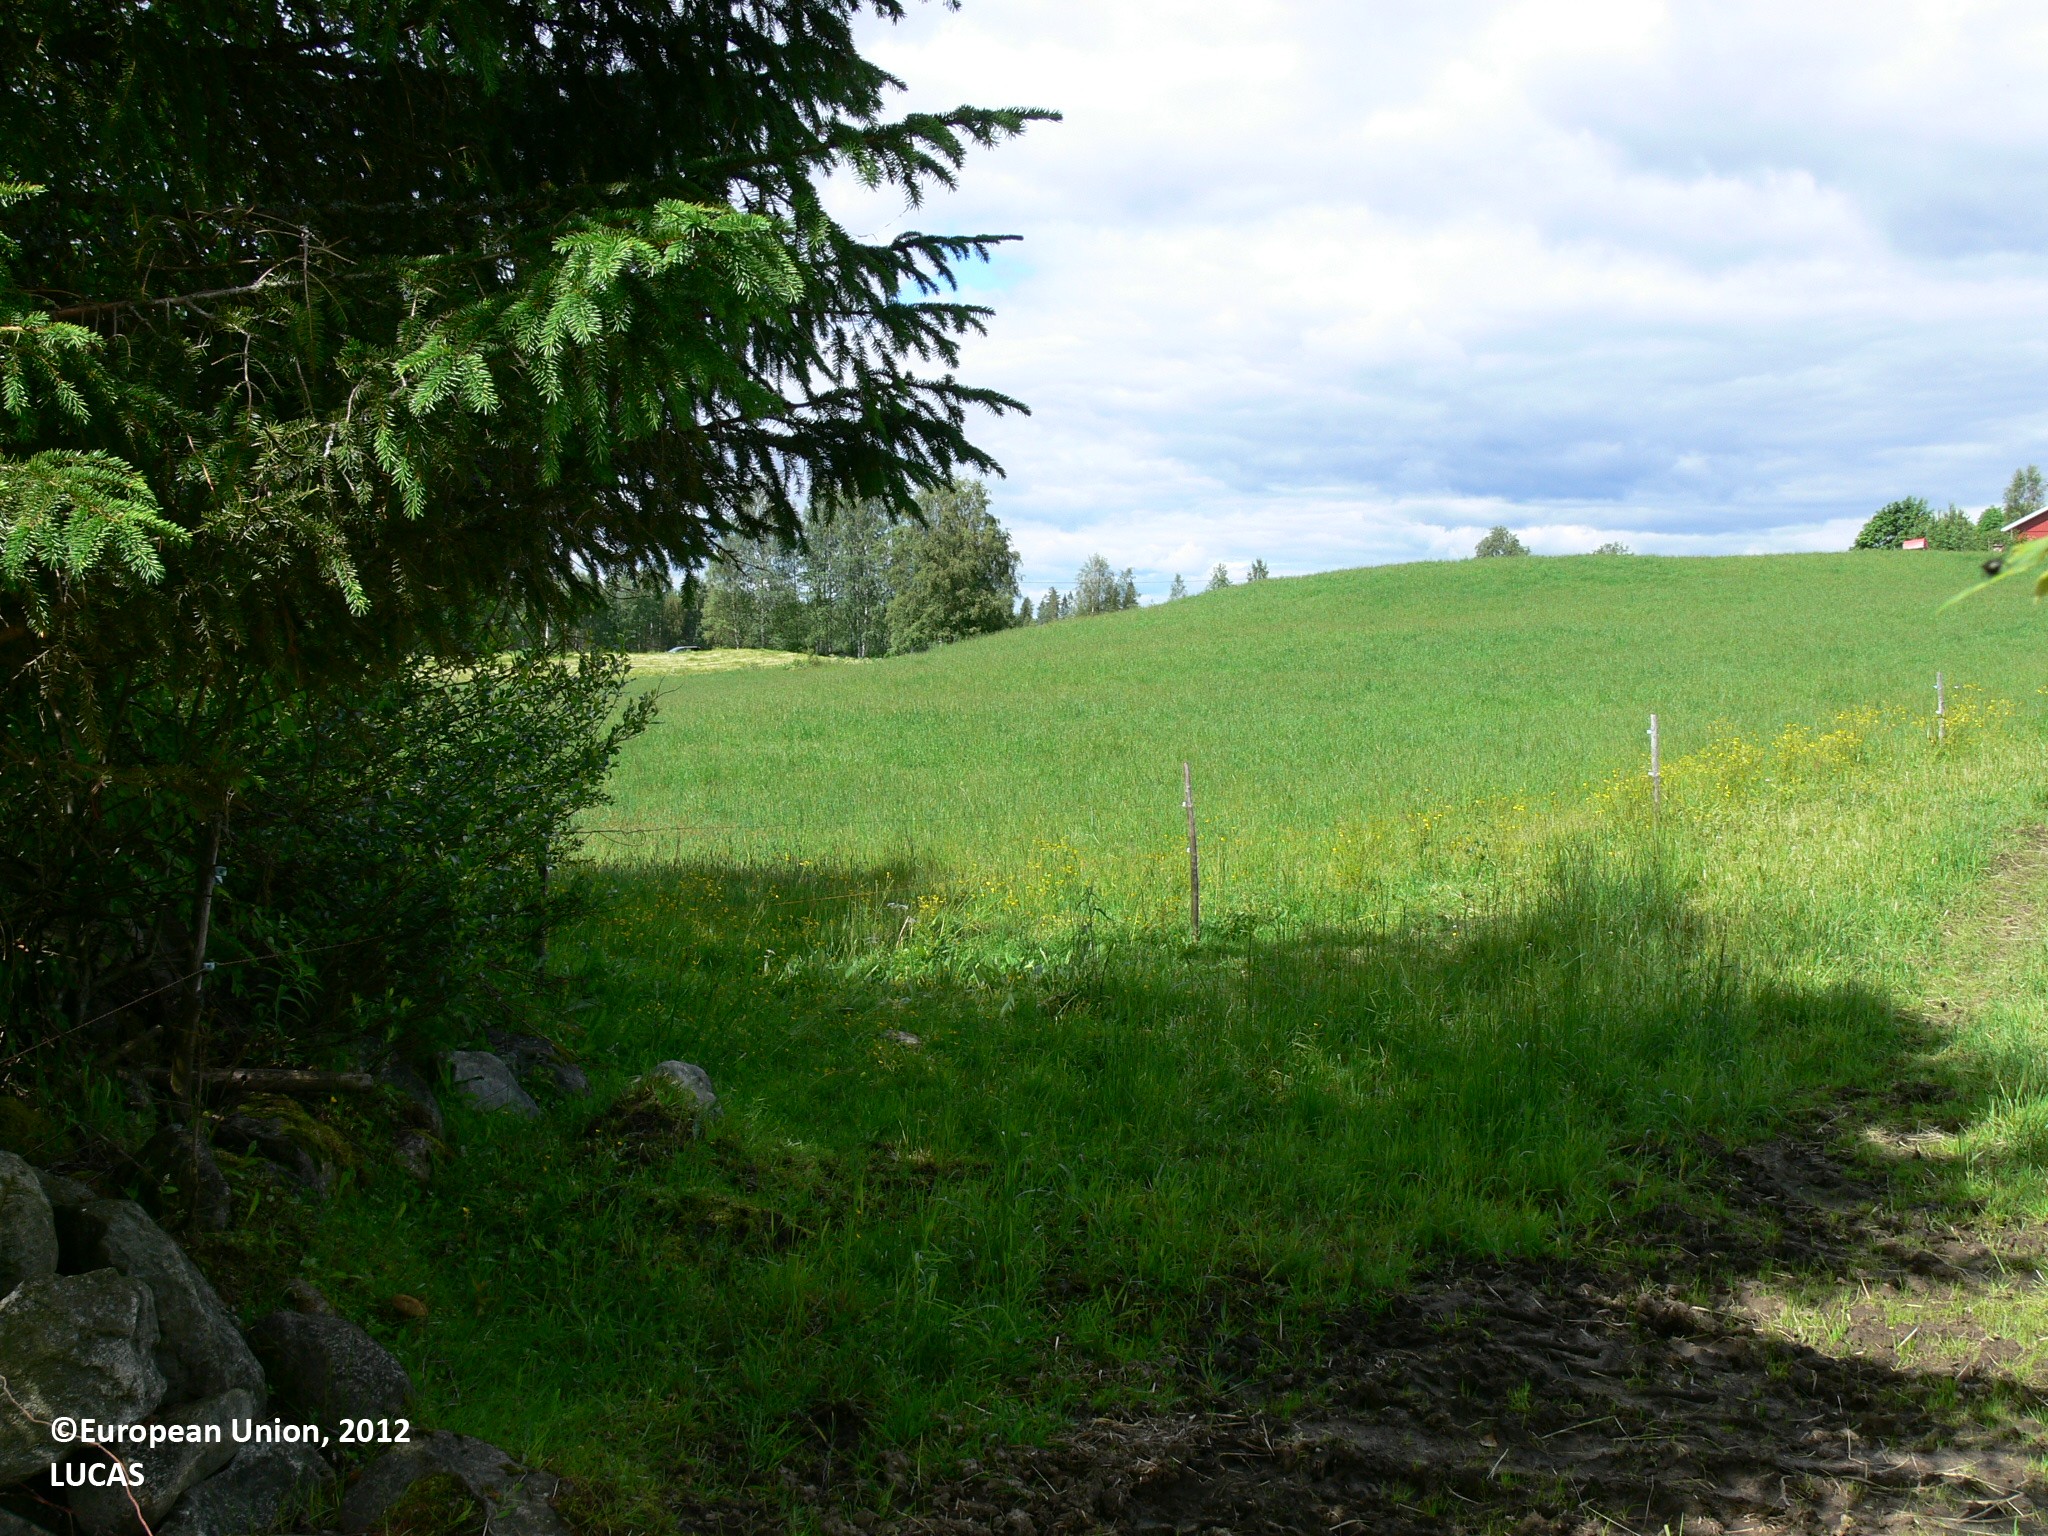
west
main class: Cropland
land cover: Temporary grasslands
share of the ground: 25 - 50 %
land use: Agriculture (excluding fallow land and kitchen gardens)
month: June
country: FI
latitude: 62.7197
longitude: 30.7268
